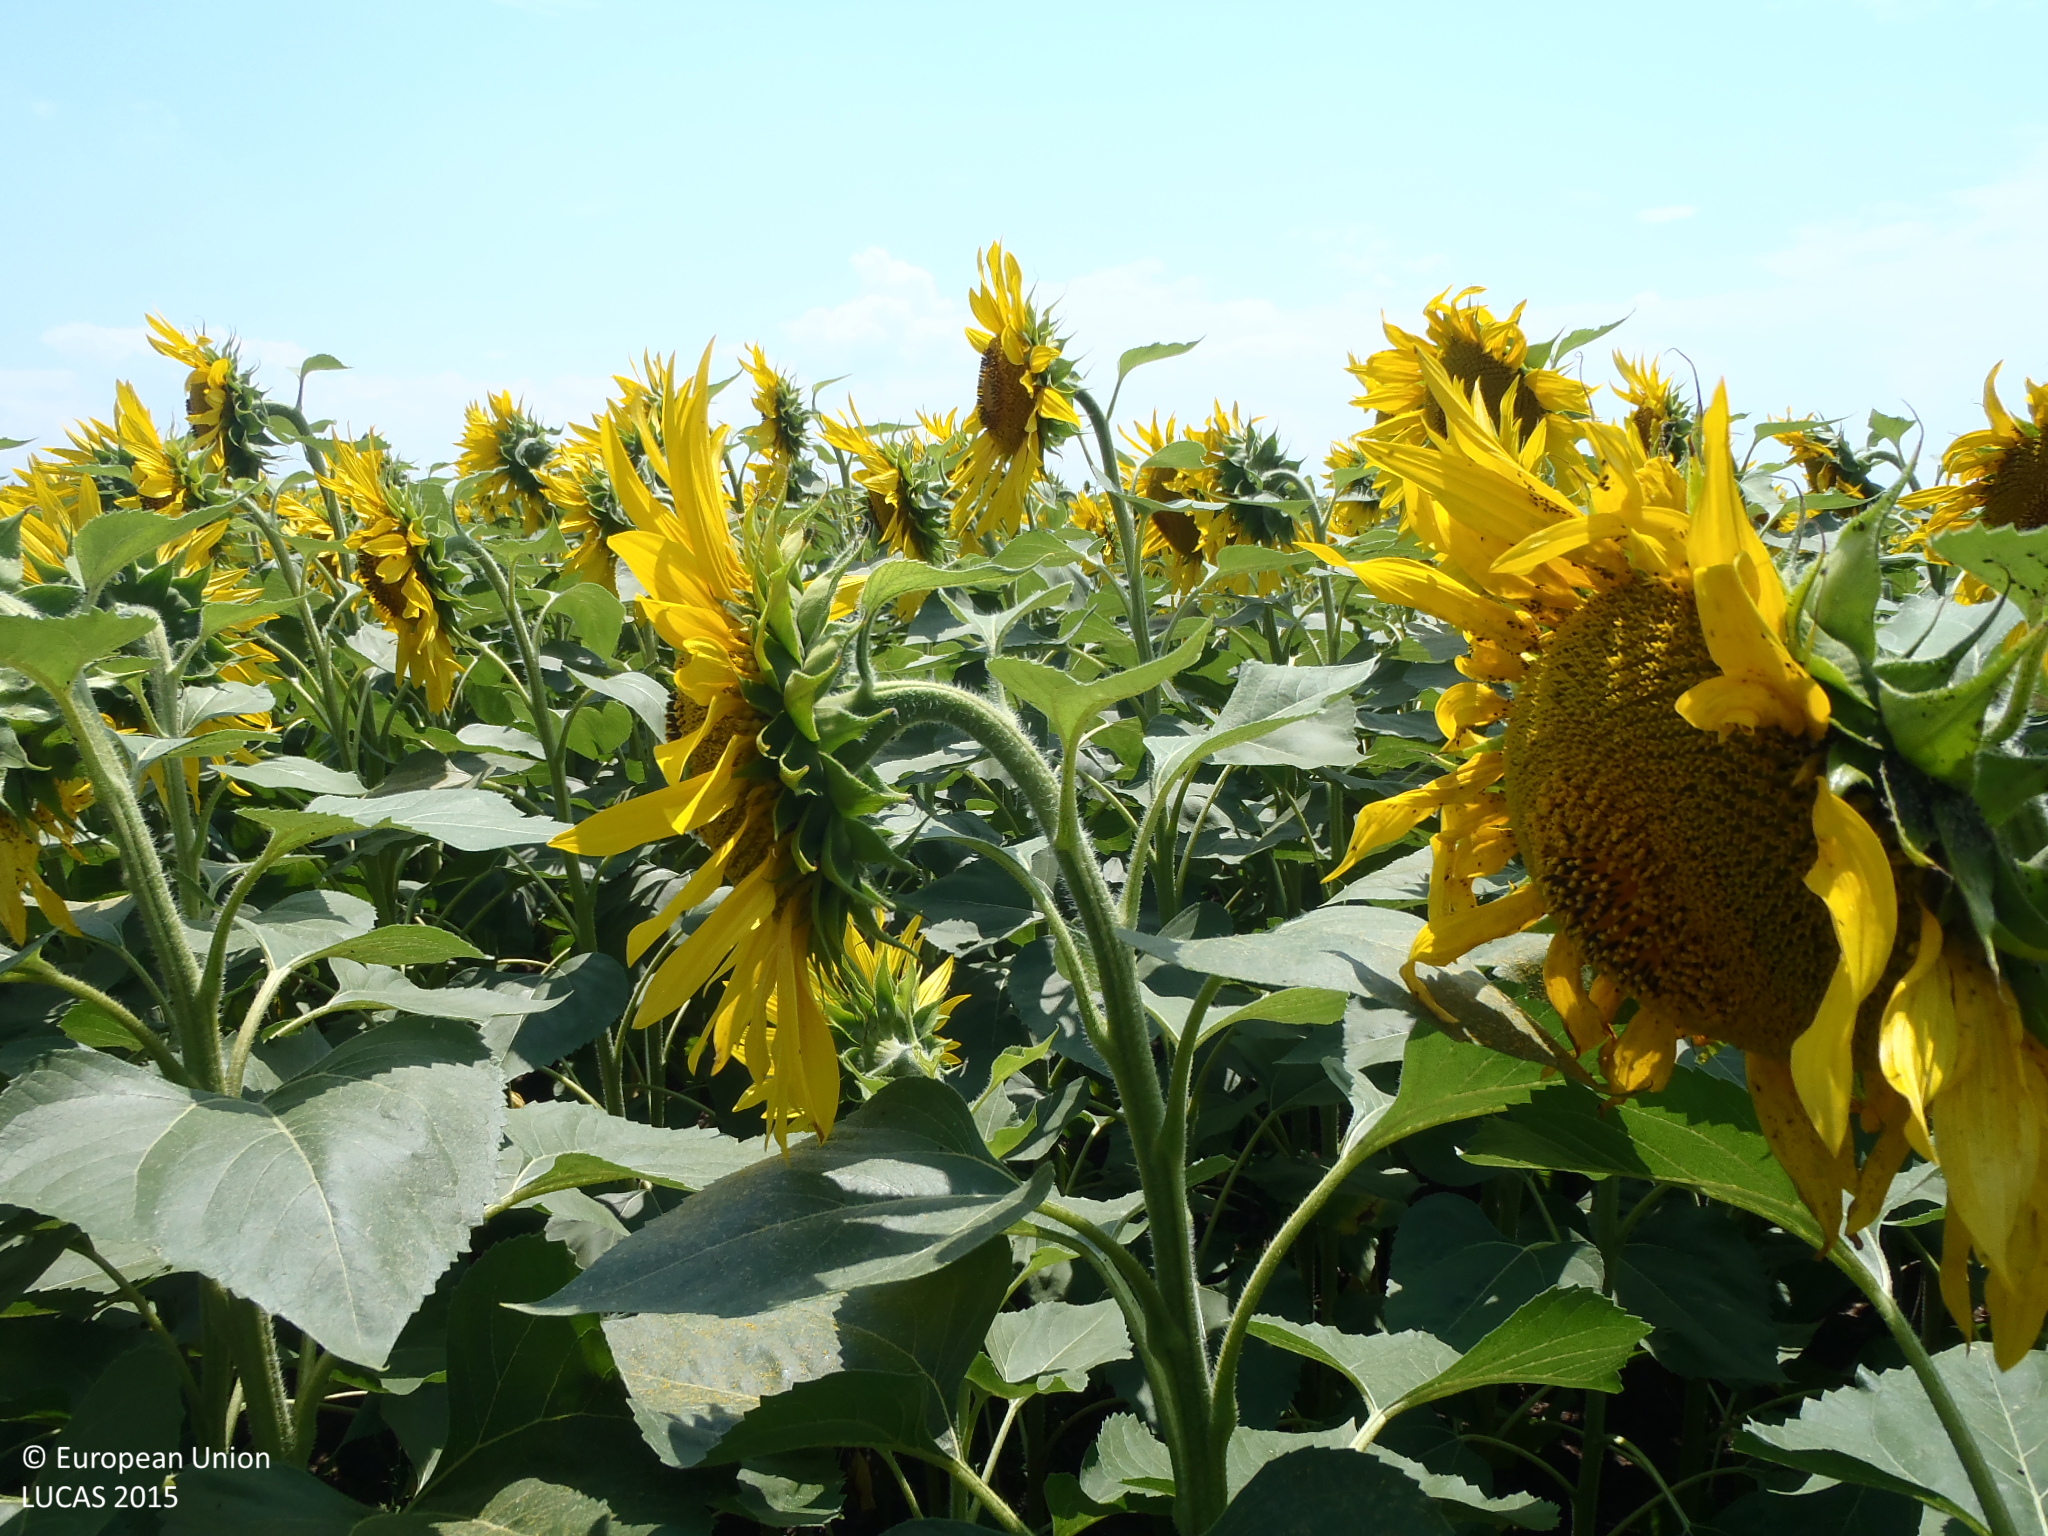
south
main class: Cropland
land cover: Sunflower
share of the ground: > 75 %
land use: Agriculture (excluding fallow land and kitchen gardens)
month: July
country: BG
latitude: 43.9450
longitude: 26.3403
